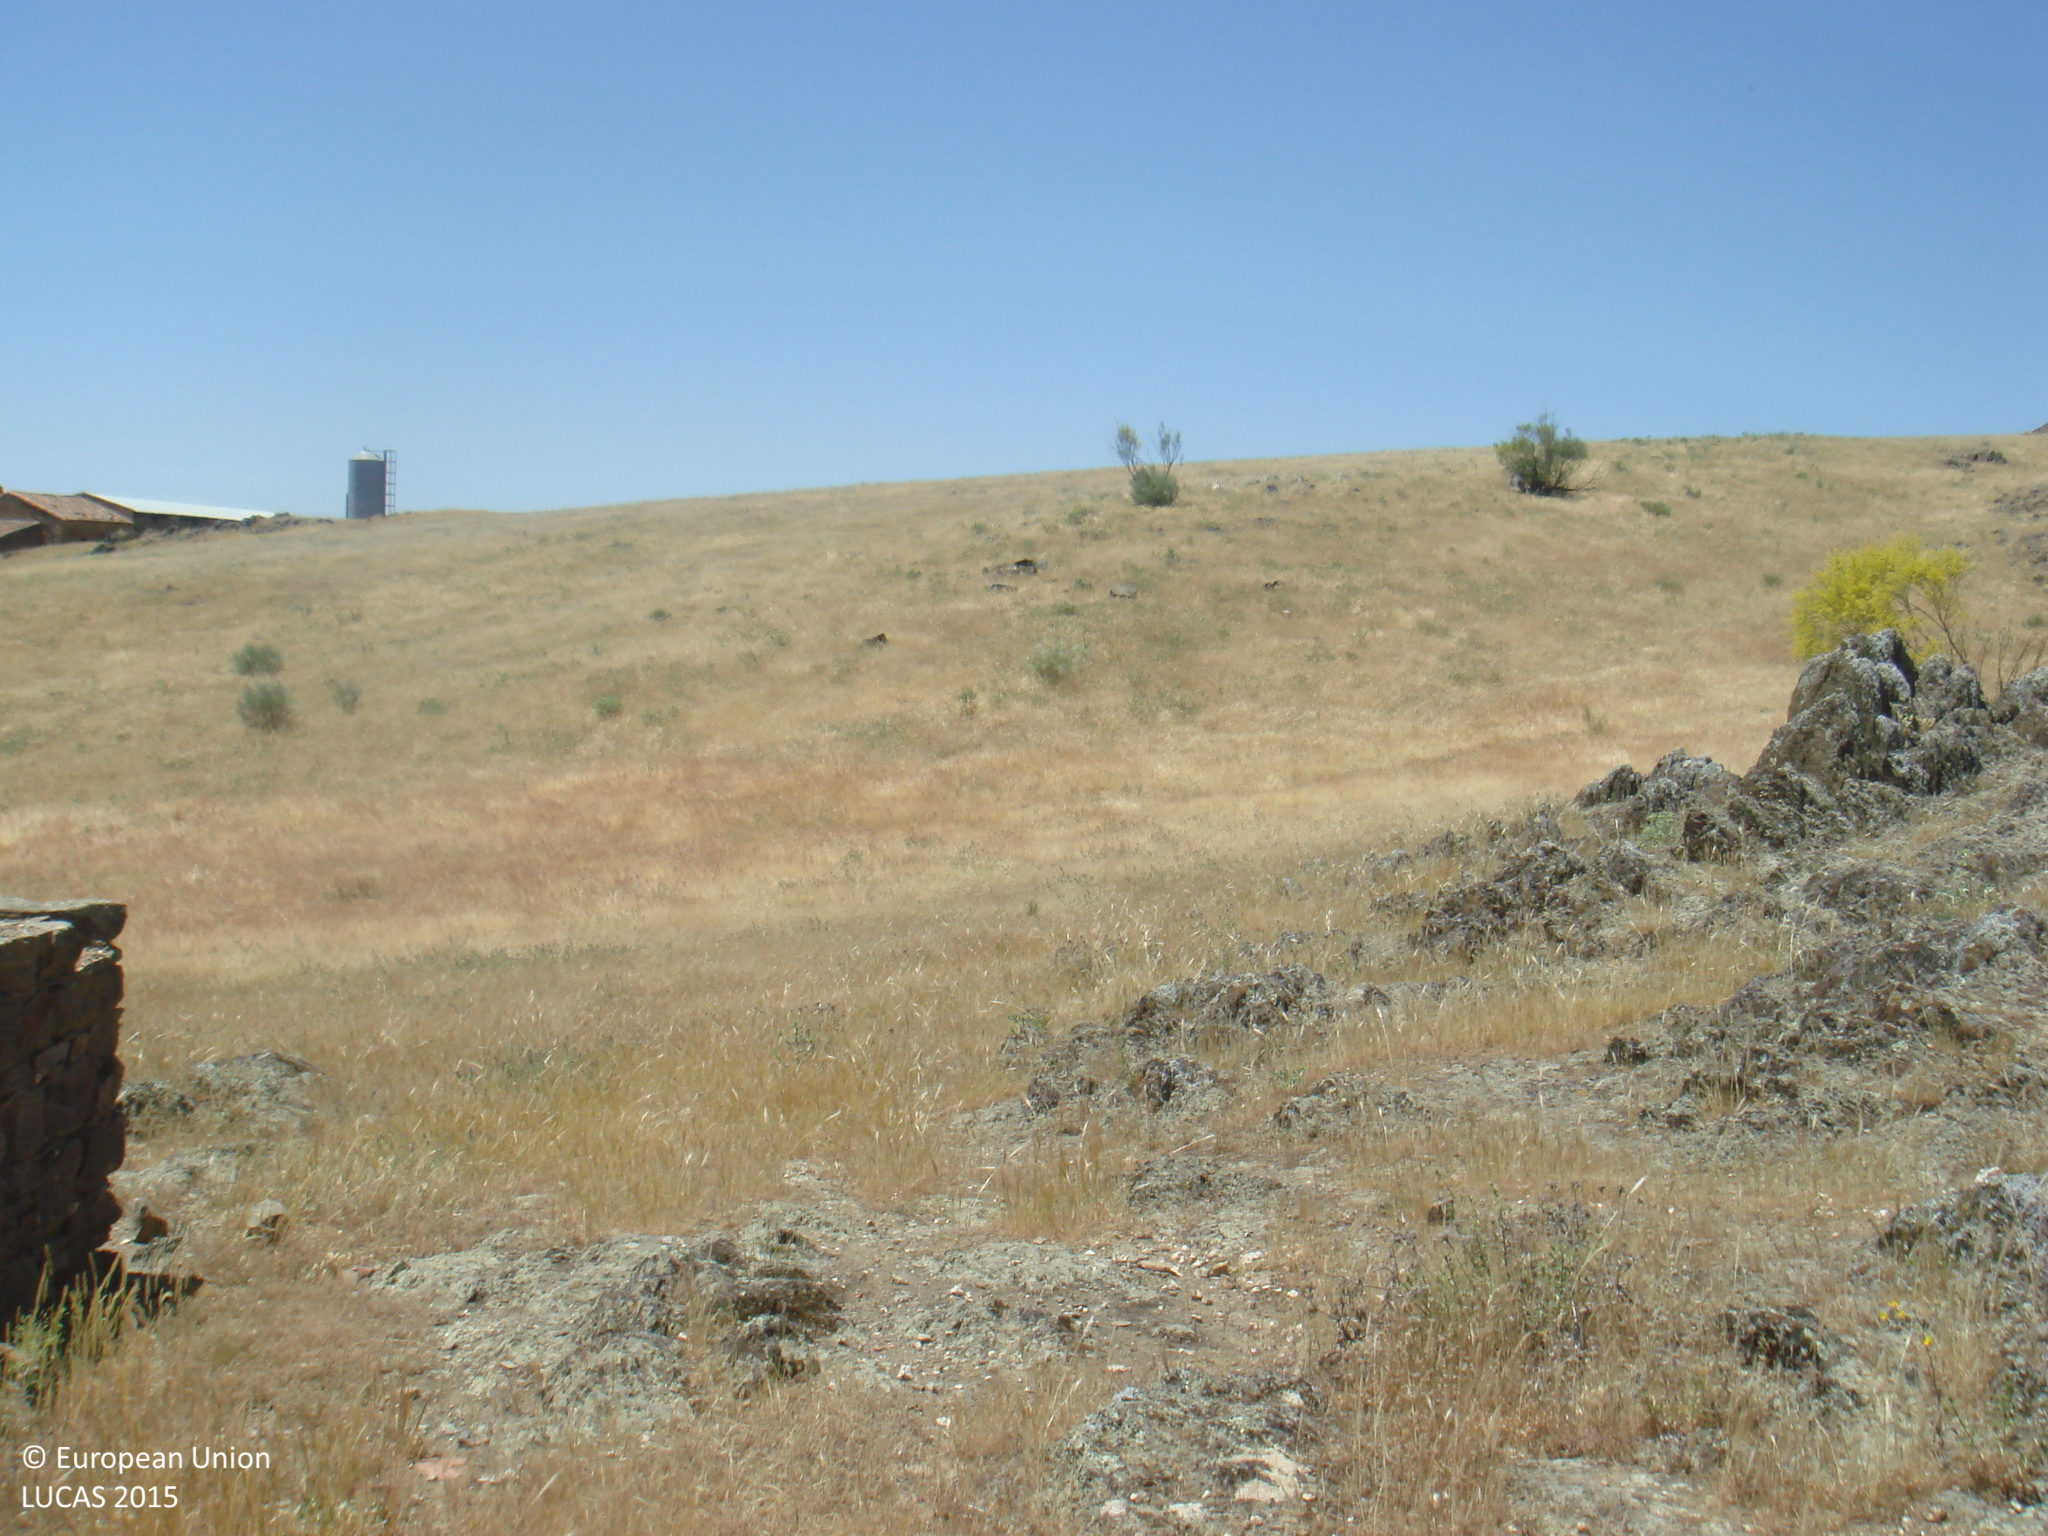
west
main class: Grassland
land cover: Grassland without tree/shrub cover
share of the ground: > 75 %
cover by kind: herbaceous plants 80 %
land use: Agriculture (excluding fallow land and kitchen gardens)
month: May
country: ES
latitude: 38.6826
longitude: -5.1261
